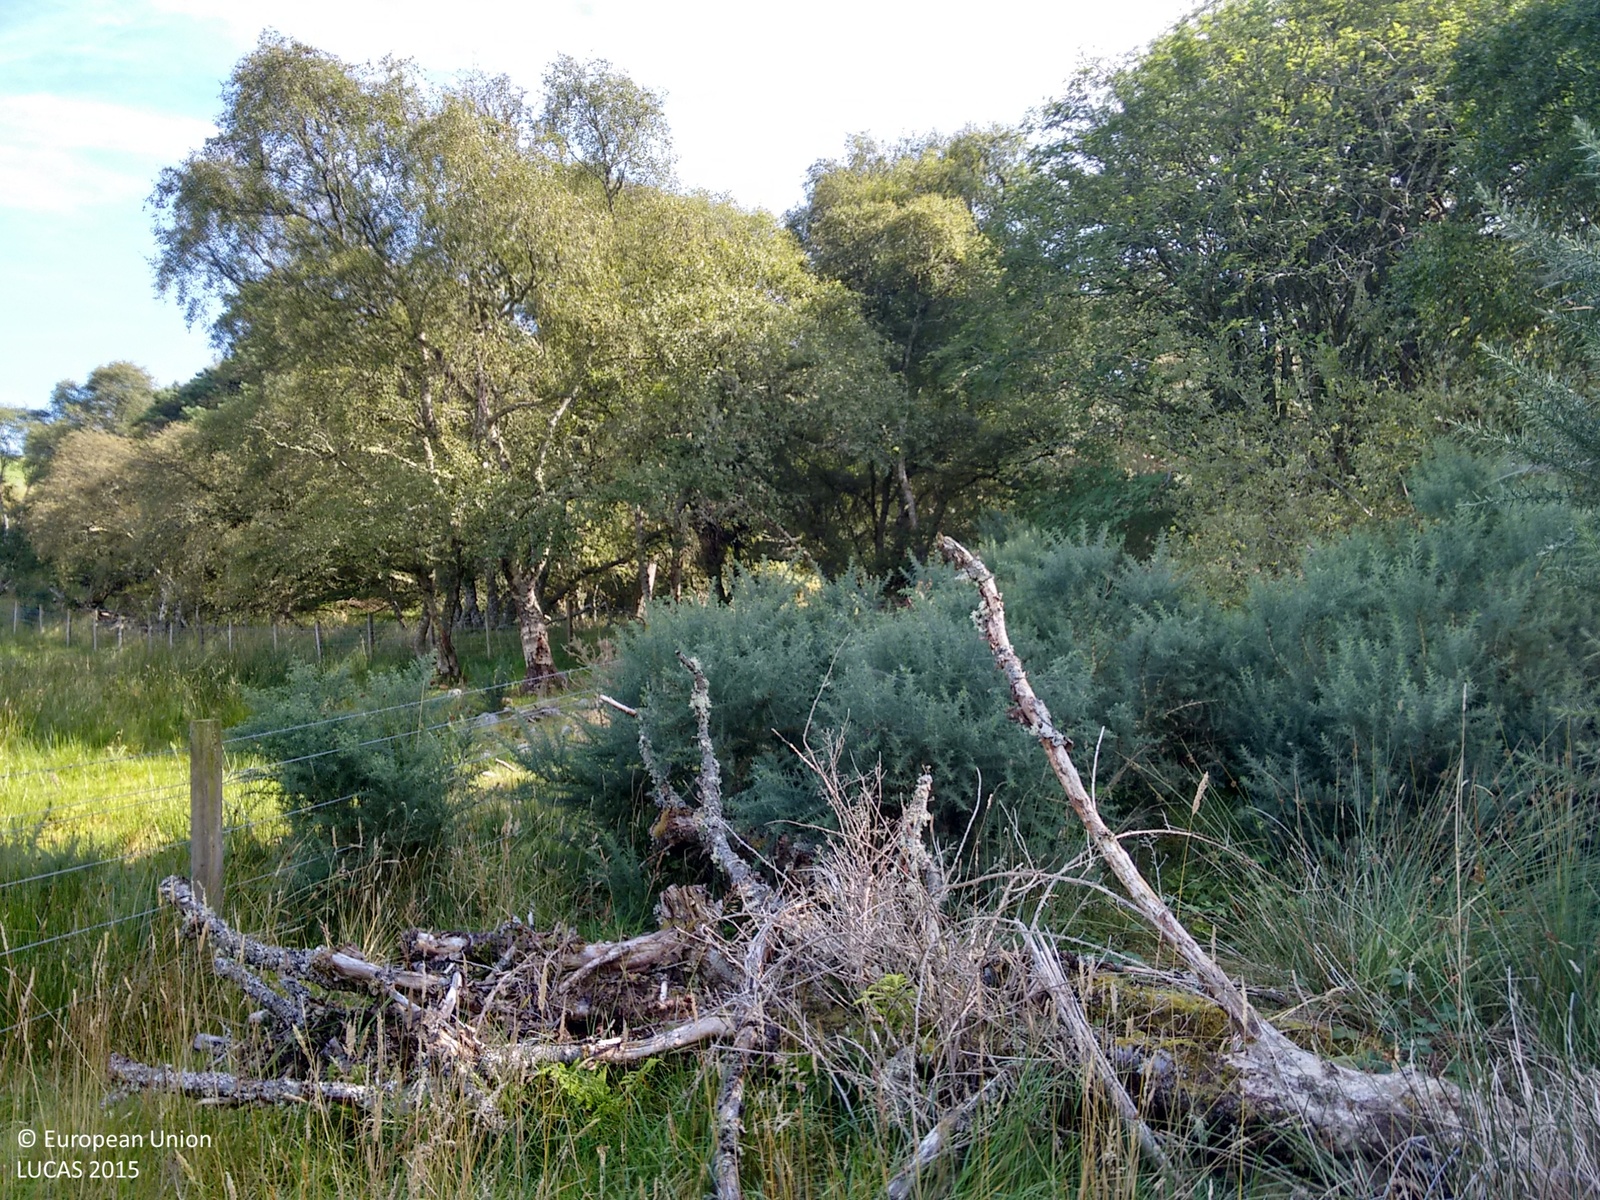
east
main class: Woodland
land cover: Pine dominated coniferous woodland
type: exotic forest
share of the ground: > 75 %
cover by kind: coniferous forest trees 80 %, shrubs 10 %, herbaceous plants 10 %
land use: Forestry
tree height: > 5 m
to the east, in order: Pine dominated coniferous woodland; Fences; Other mixed woodland; Grassland without tree/shrub cover; Abandoned hedges; Fences; Lines of trees; Dry stone walls; Shrubland without tree cover; Fences; Shrubland without tree cover
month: September
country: GB
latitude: 57.8848
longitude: -4.3363
